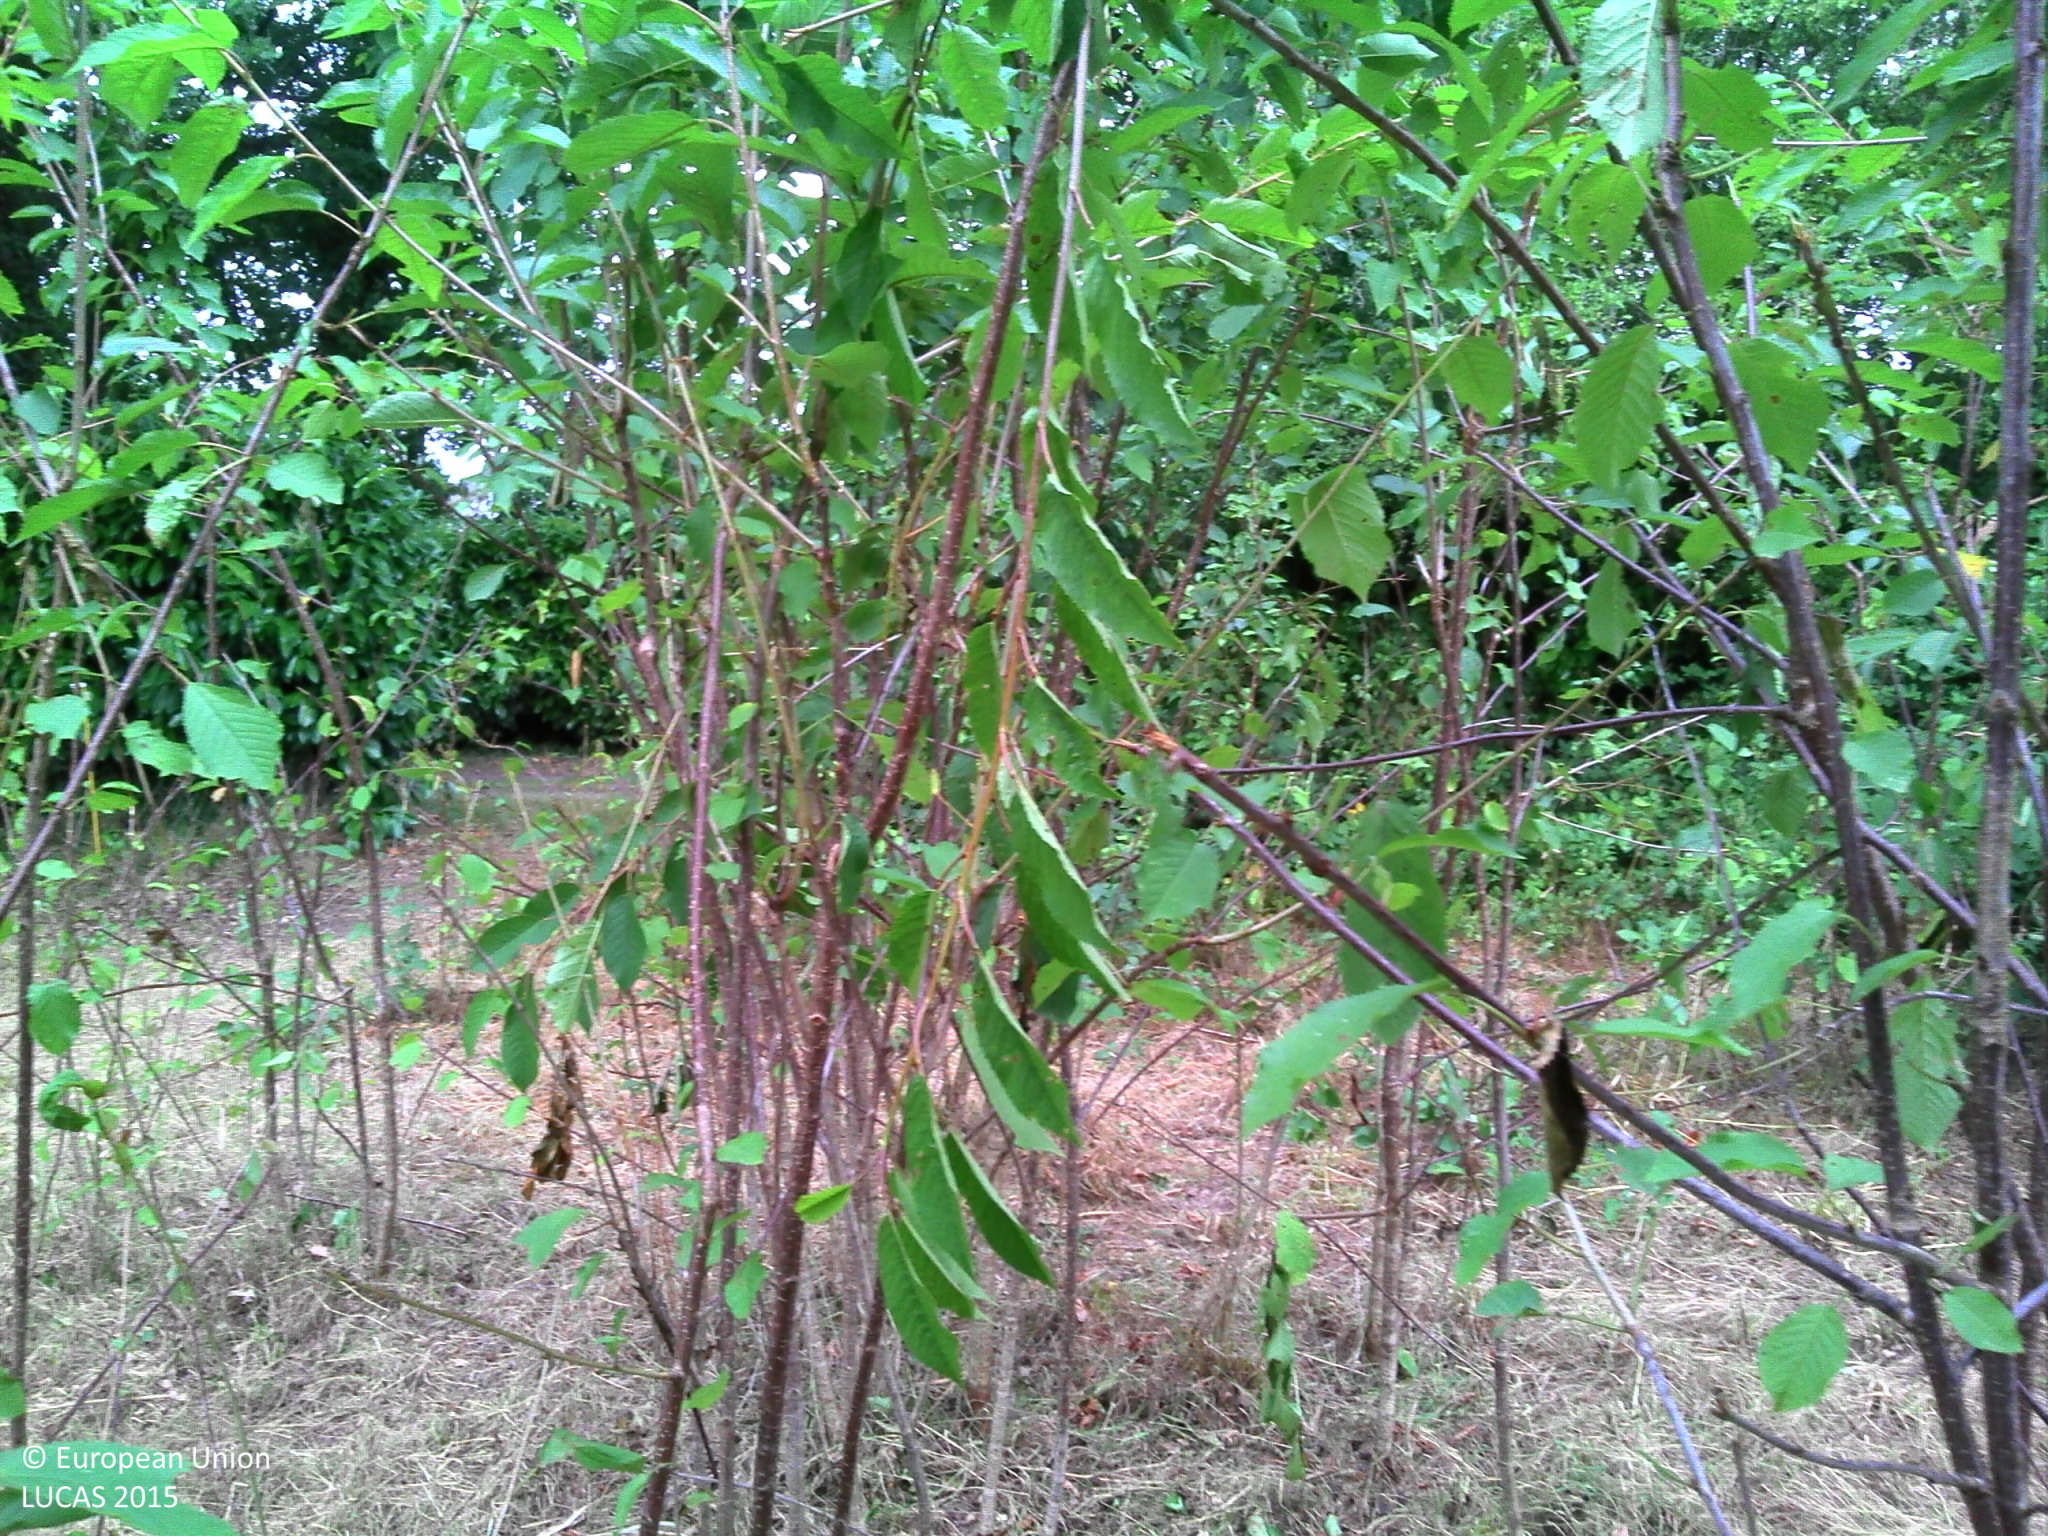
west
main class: Shrubland
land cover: Shrubland with sparse tree cover
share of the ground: > 75 %
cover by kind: shrubs 50 %, herbaceous plants 45 %, broadleaved forest trees 5 %
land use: Agriculture (excluding fallow land and kitchen gardens)
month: July
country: FR
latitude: 47.5329
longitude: -1.9645
